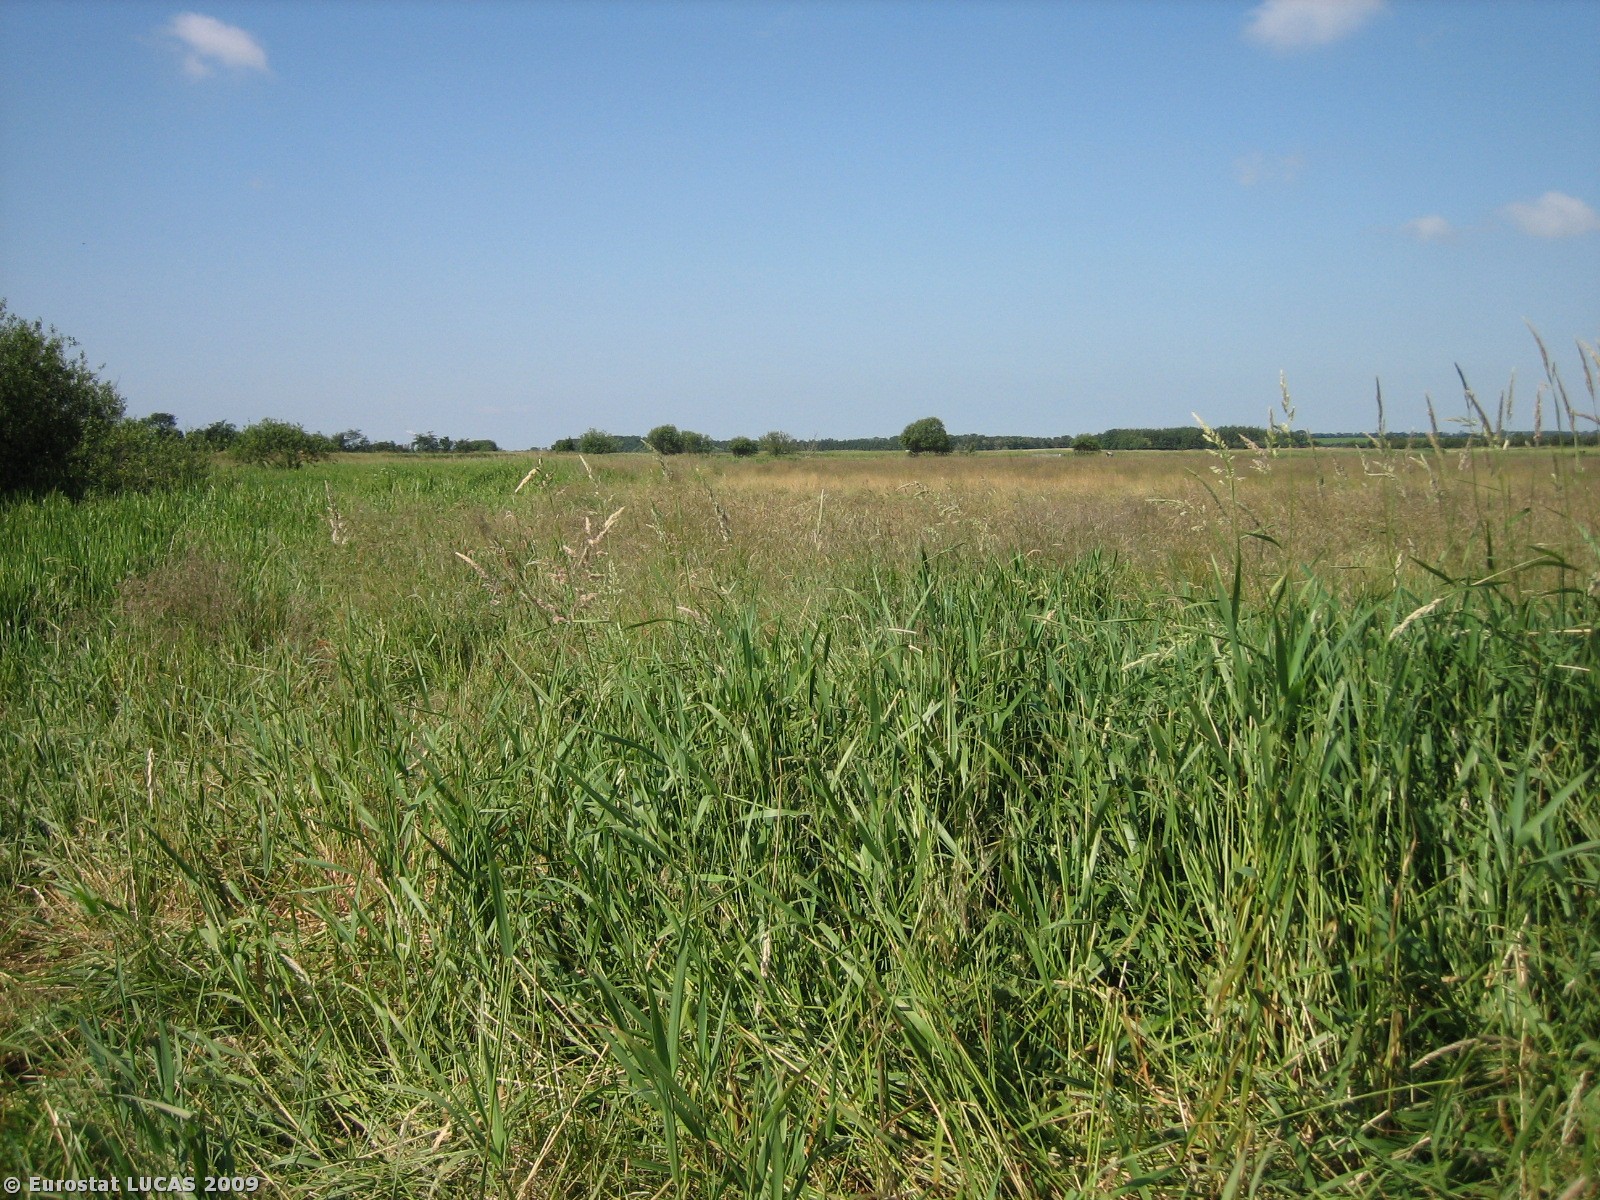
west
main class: Grassland
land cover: Grassland without tree/shrub cover
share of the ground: > 75 %
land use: Agriculture (excluding fallow land and kitchen gardens)
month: July
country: DK
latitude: 55.4093
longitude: 8.8165
